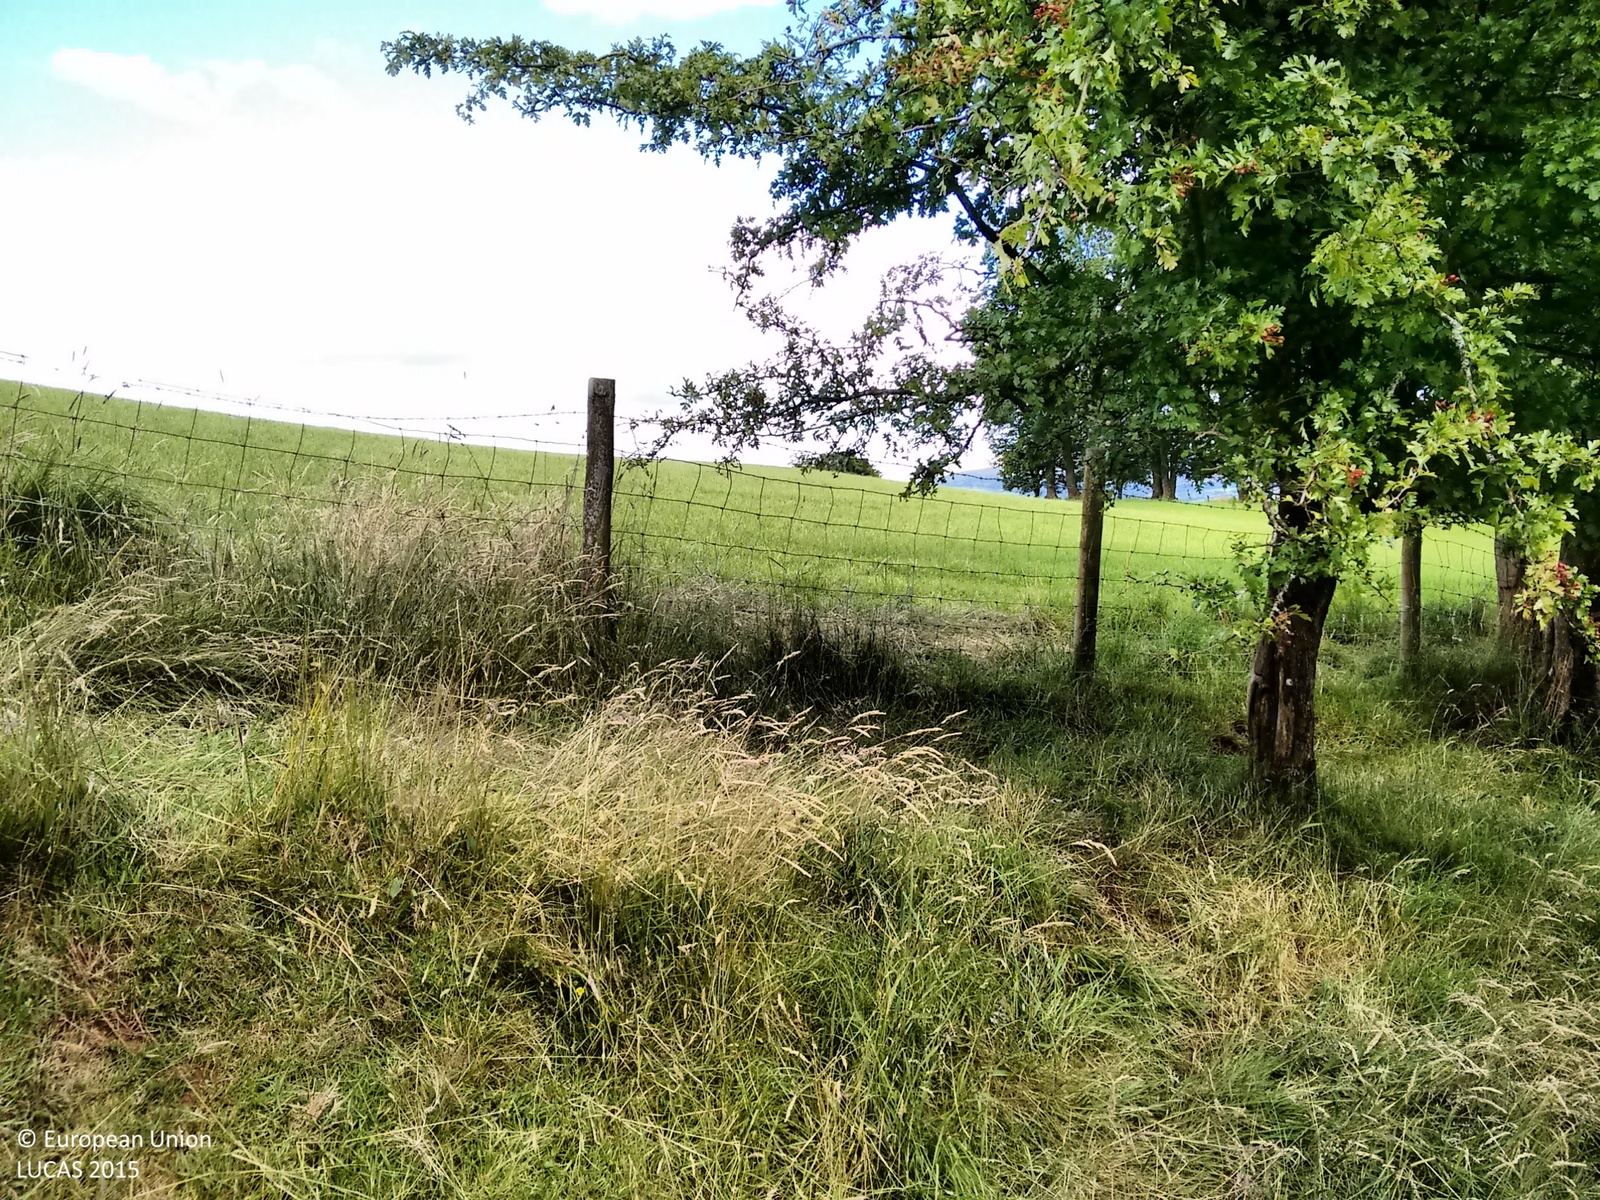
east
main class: Grassland
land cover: Grassland without tree/shrub cover
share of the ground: > 75 %
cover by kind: herbaceous plants 100 %
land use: Agriculture (excluding fallow land and kitchen gardens)
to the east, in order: Grassland without tree/shrub cover; Lines of trees; Fences; Grassland without tree/shrub cover; Lines of trees; Fences; Grassland without tree/shrub cover; Fences; Managed hedges; Fences; Grassland without tree/shrub cover
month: July
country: GB
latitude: 51.8854
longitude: -3.8798
